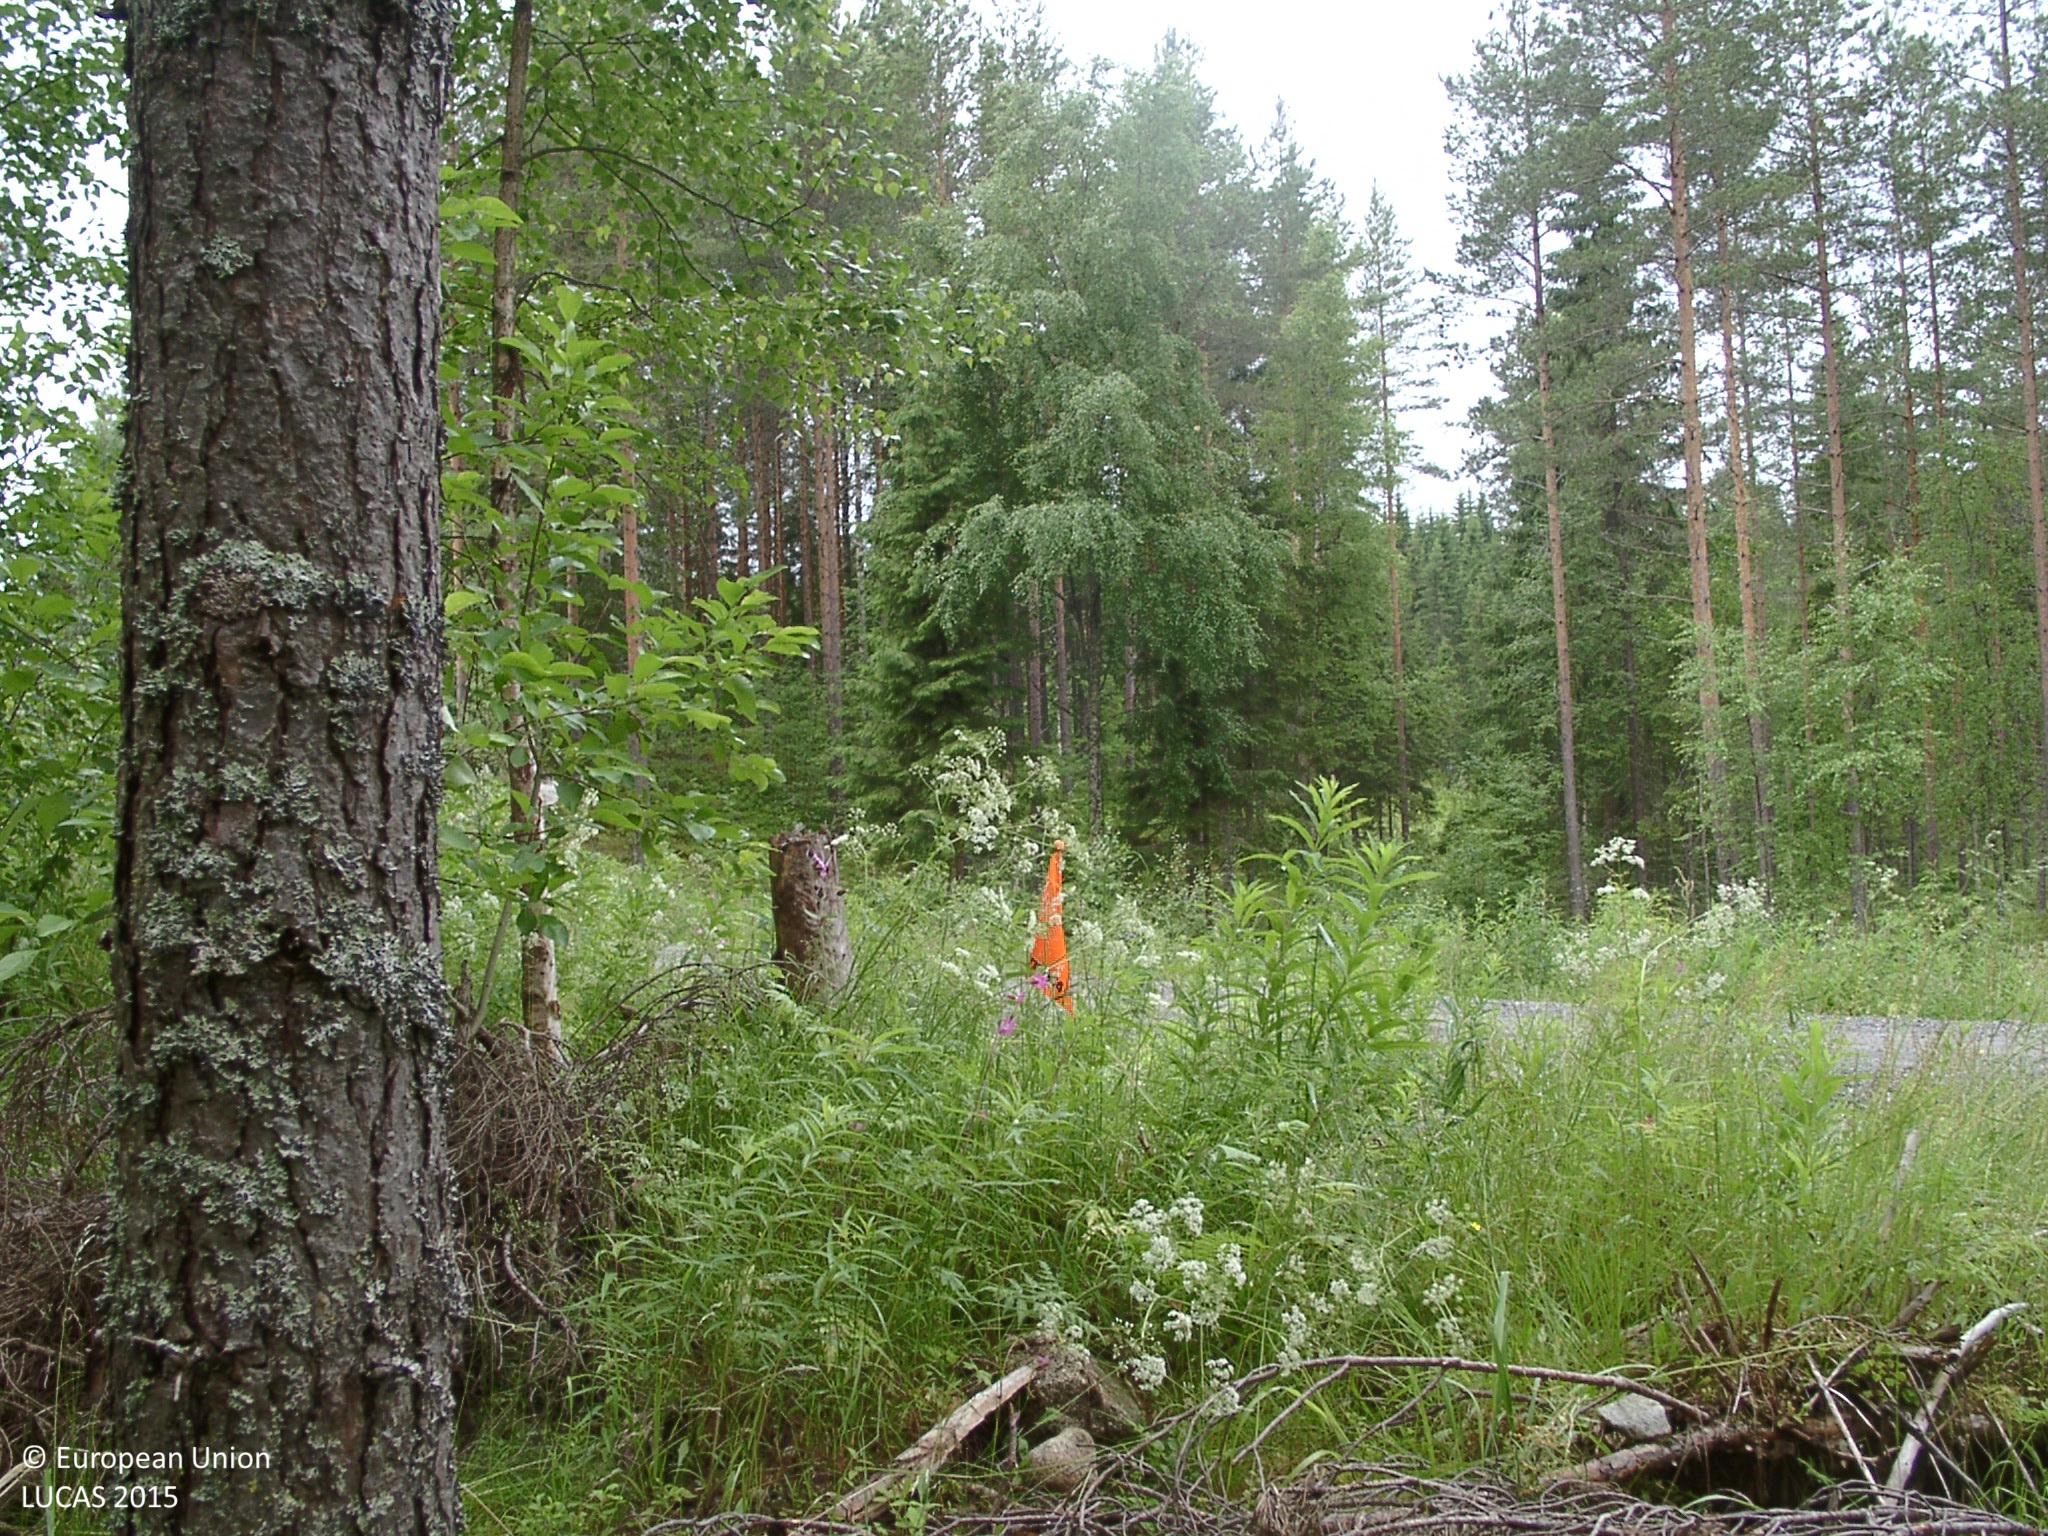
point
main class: Woodland
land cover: Other coniferous woodland
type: boreal forest
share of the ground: 50 - 75 %
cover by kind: coniferous forest trees 65 %, shrubs 10 %, herbaceous plants 10 %, broadleaved forest trees 5 %, lichens and mosses 5 %
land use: Forestry
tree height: > 5 m
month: July
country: FI
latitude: 62.0587
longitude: 25.5166
